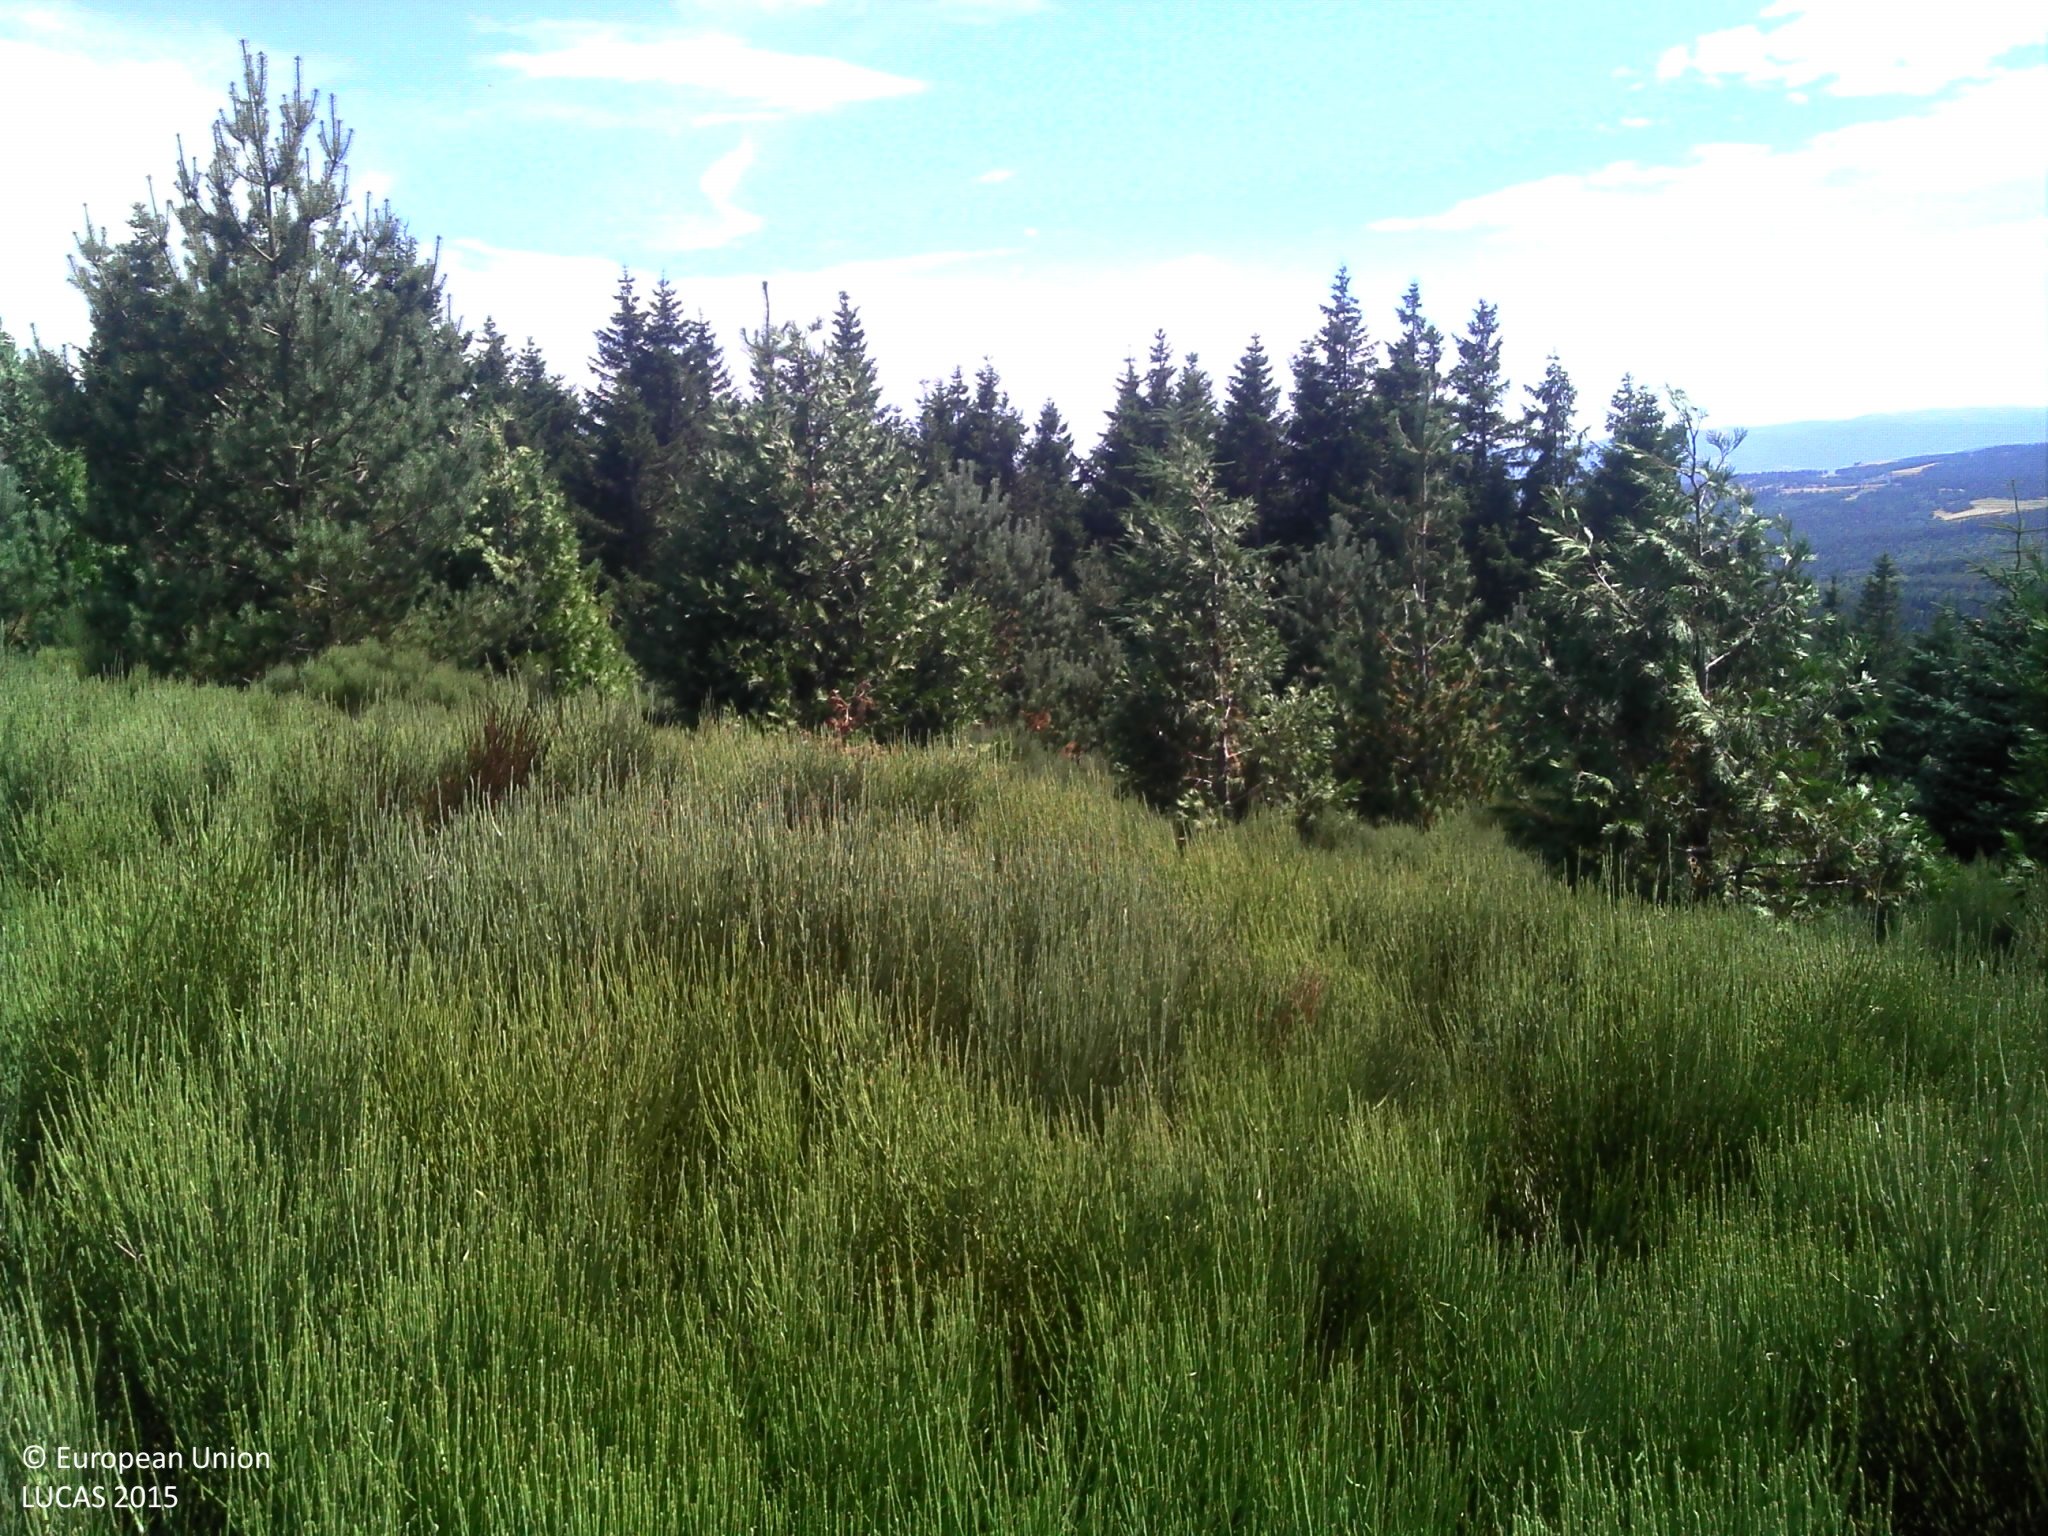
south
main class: Shrubland
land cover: Shrubland with sparse tree cover
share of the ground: > 75 %
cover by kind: shrubs 95 %, coniferous forest trees 5 %
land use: Semi-natural and natural areas not in use
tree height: < 5 m
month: July
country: FR
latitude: 44.6062
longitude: 3.9199
